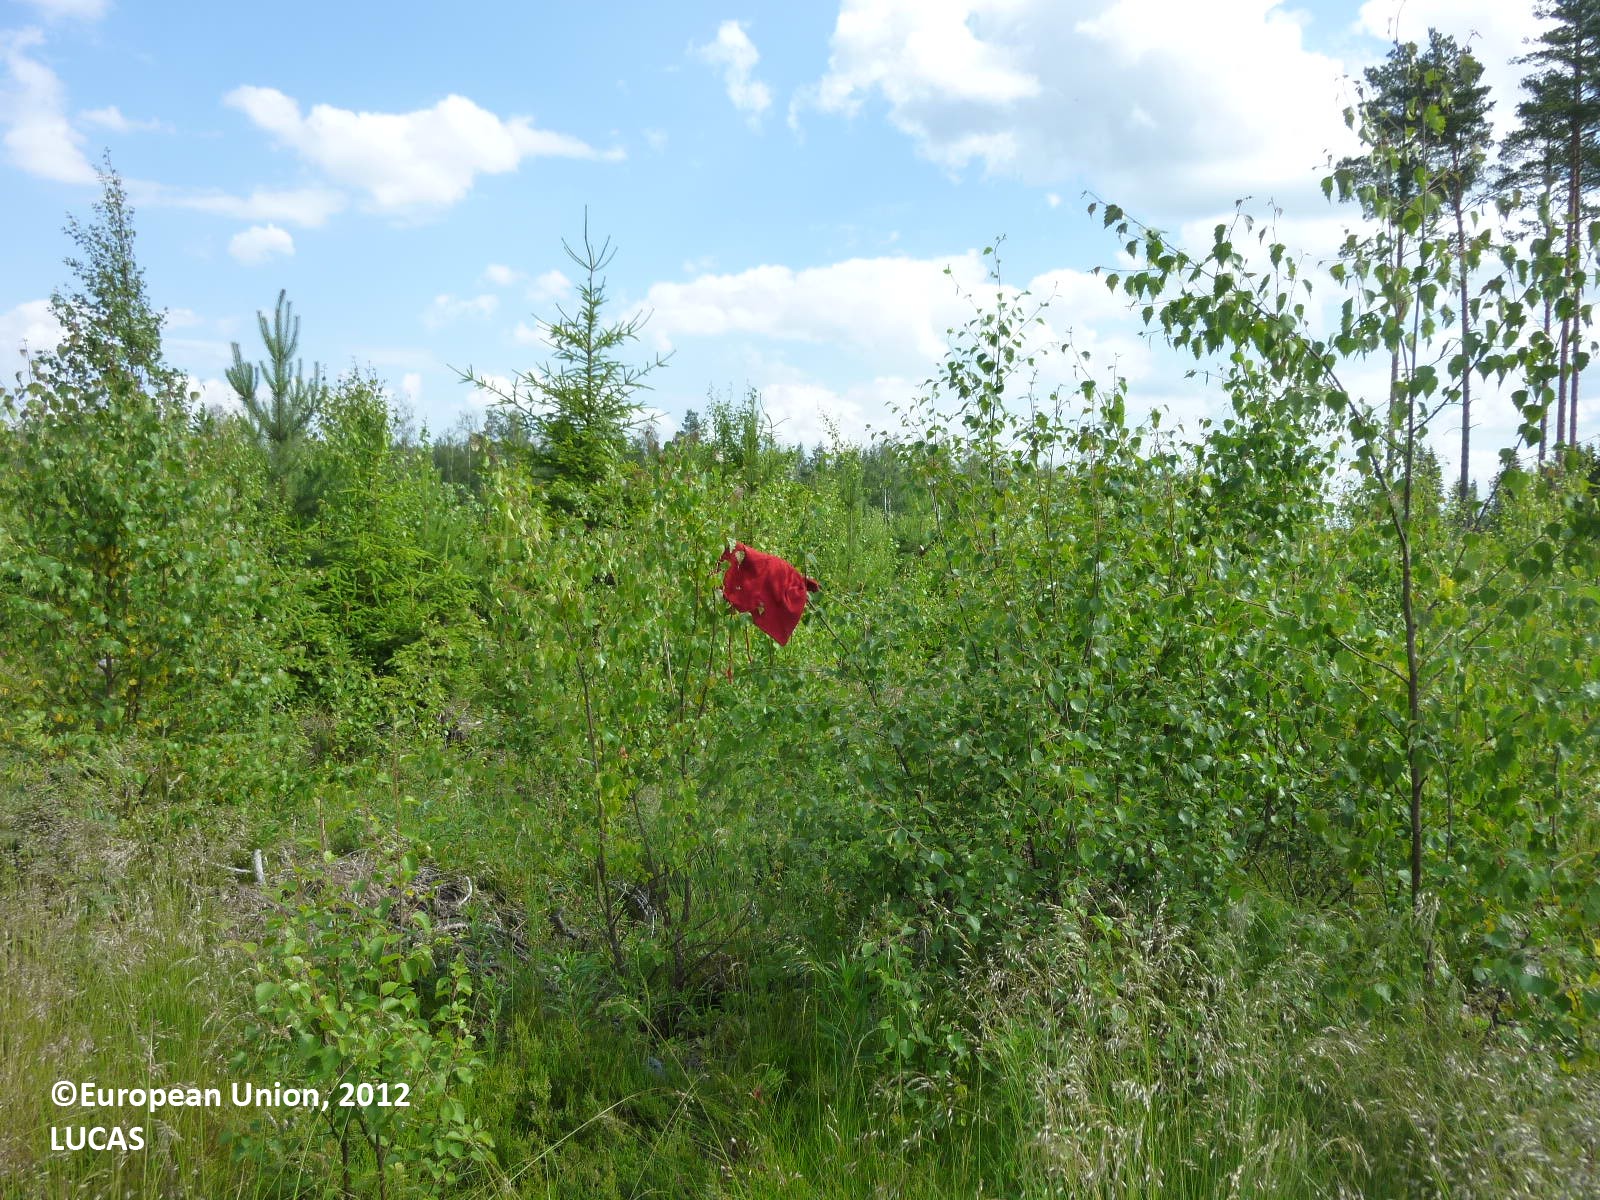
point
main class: Woodland
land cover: Other mixed woodland
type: boreal forest
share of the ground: 50 - 75 %
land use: Forestry
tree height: < 5 m
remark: Clear cut
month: July
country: FI
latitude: 61.2046
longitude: 22.3652
